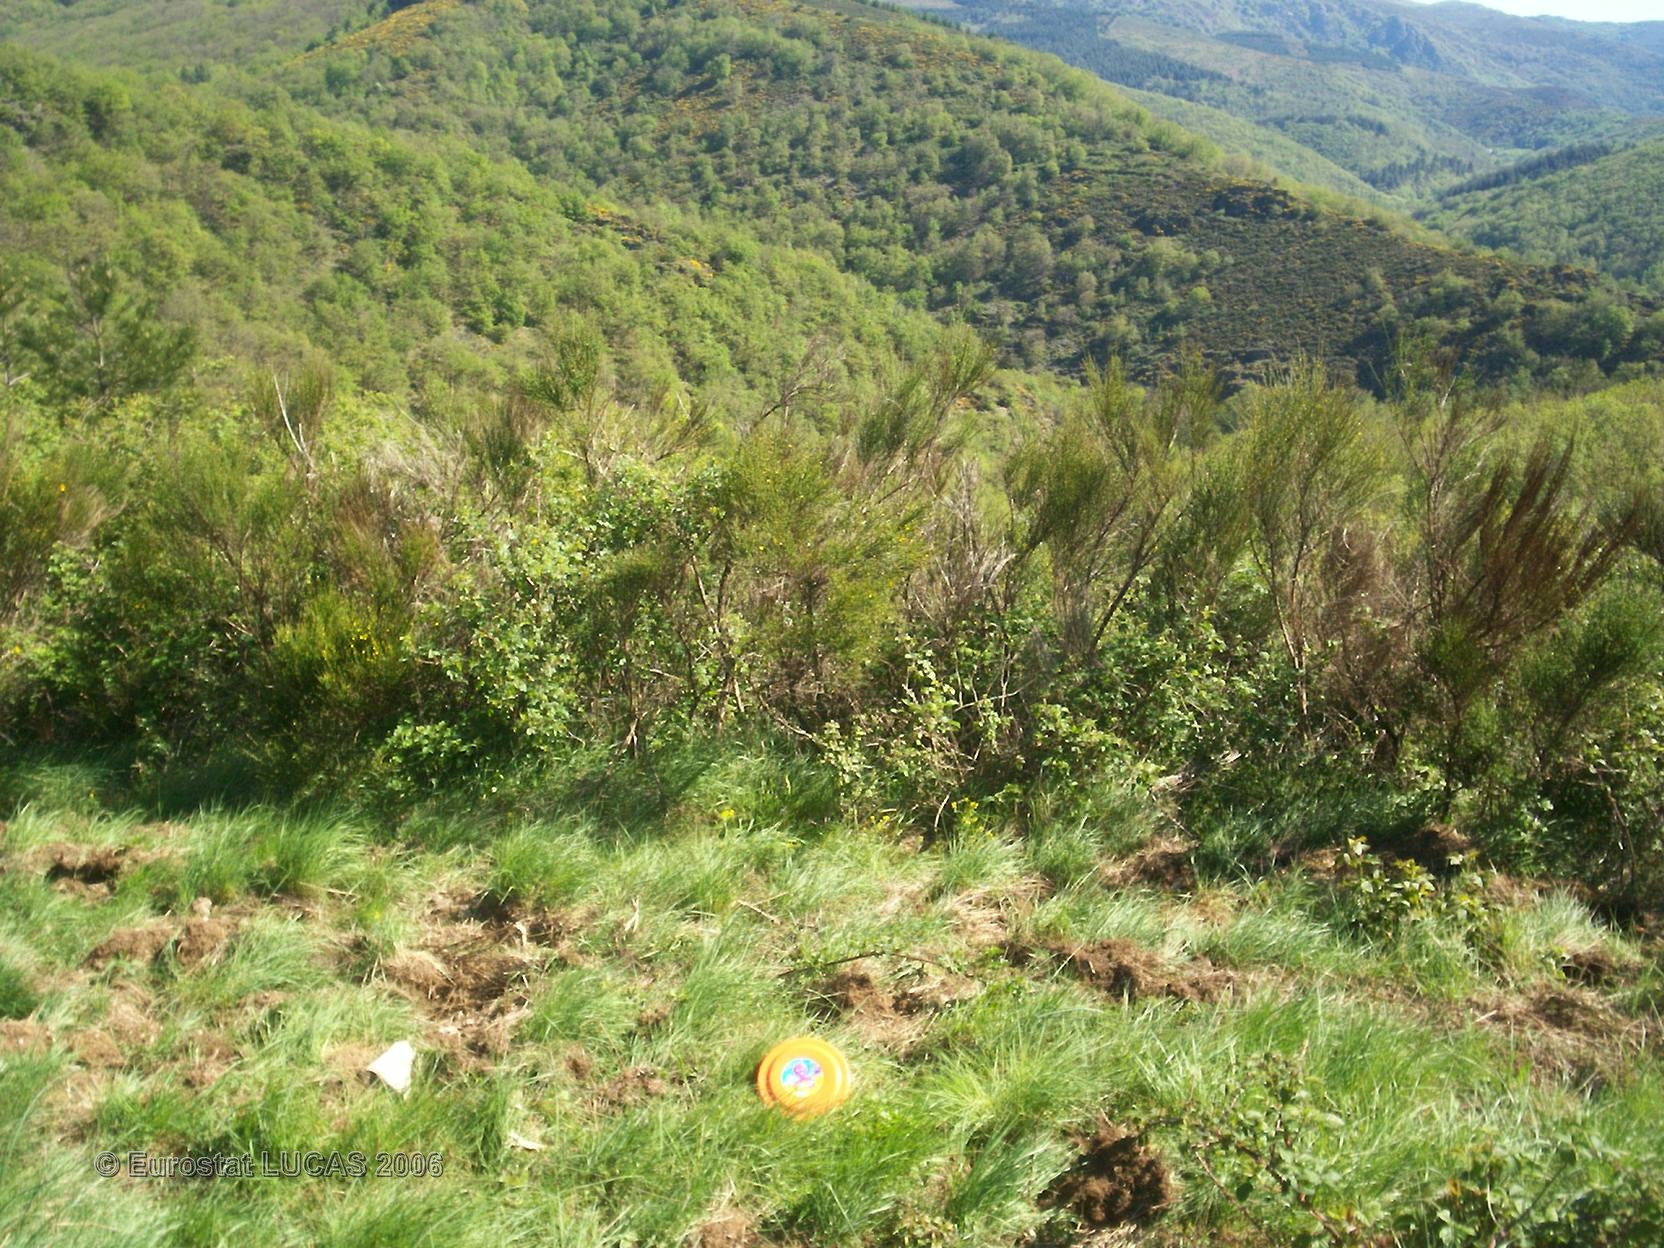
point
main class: Grassland
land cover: Grassland without tree/shrub cover
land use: Agriculture (excluding fallow land and kitchen gardens)
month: May
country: FR
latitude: 43.9799
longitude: 3.4372
